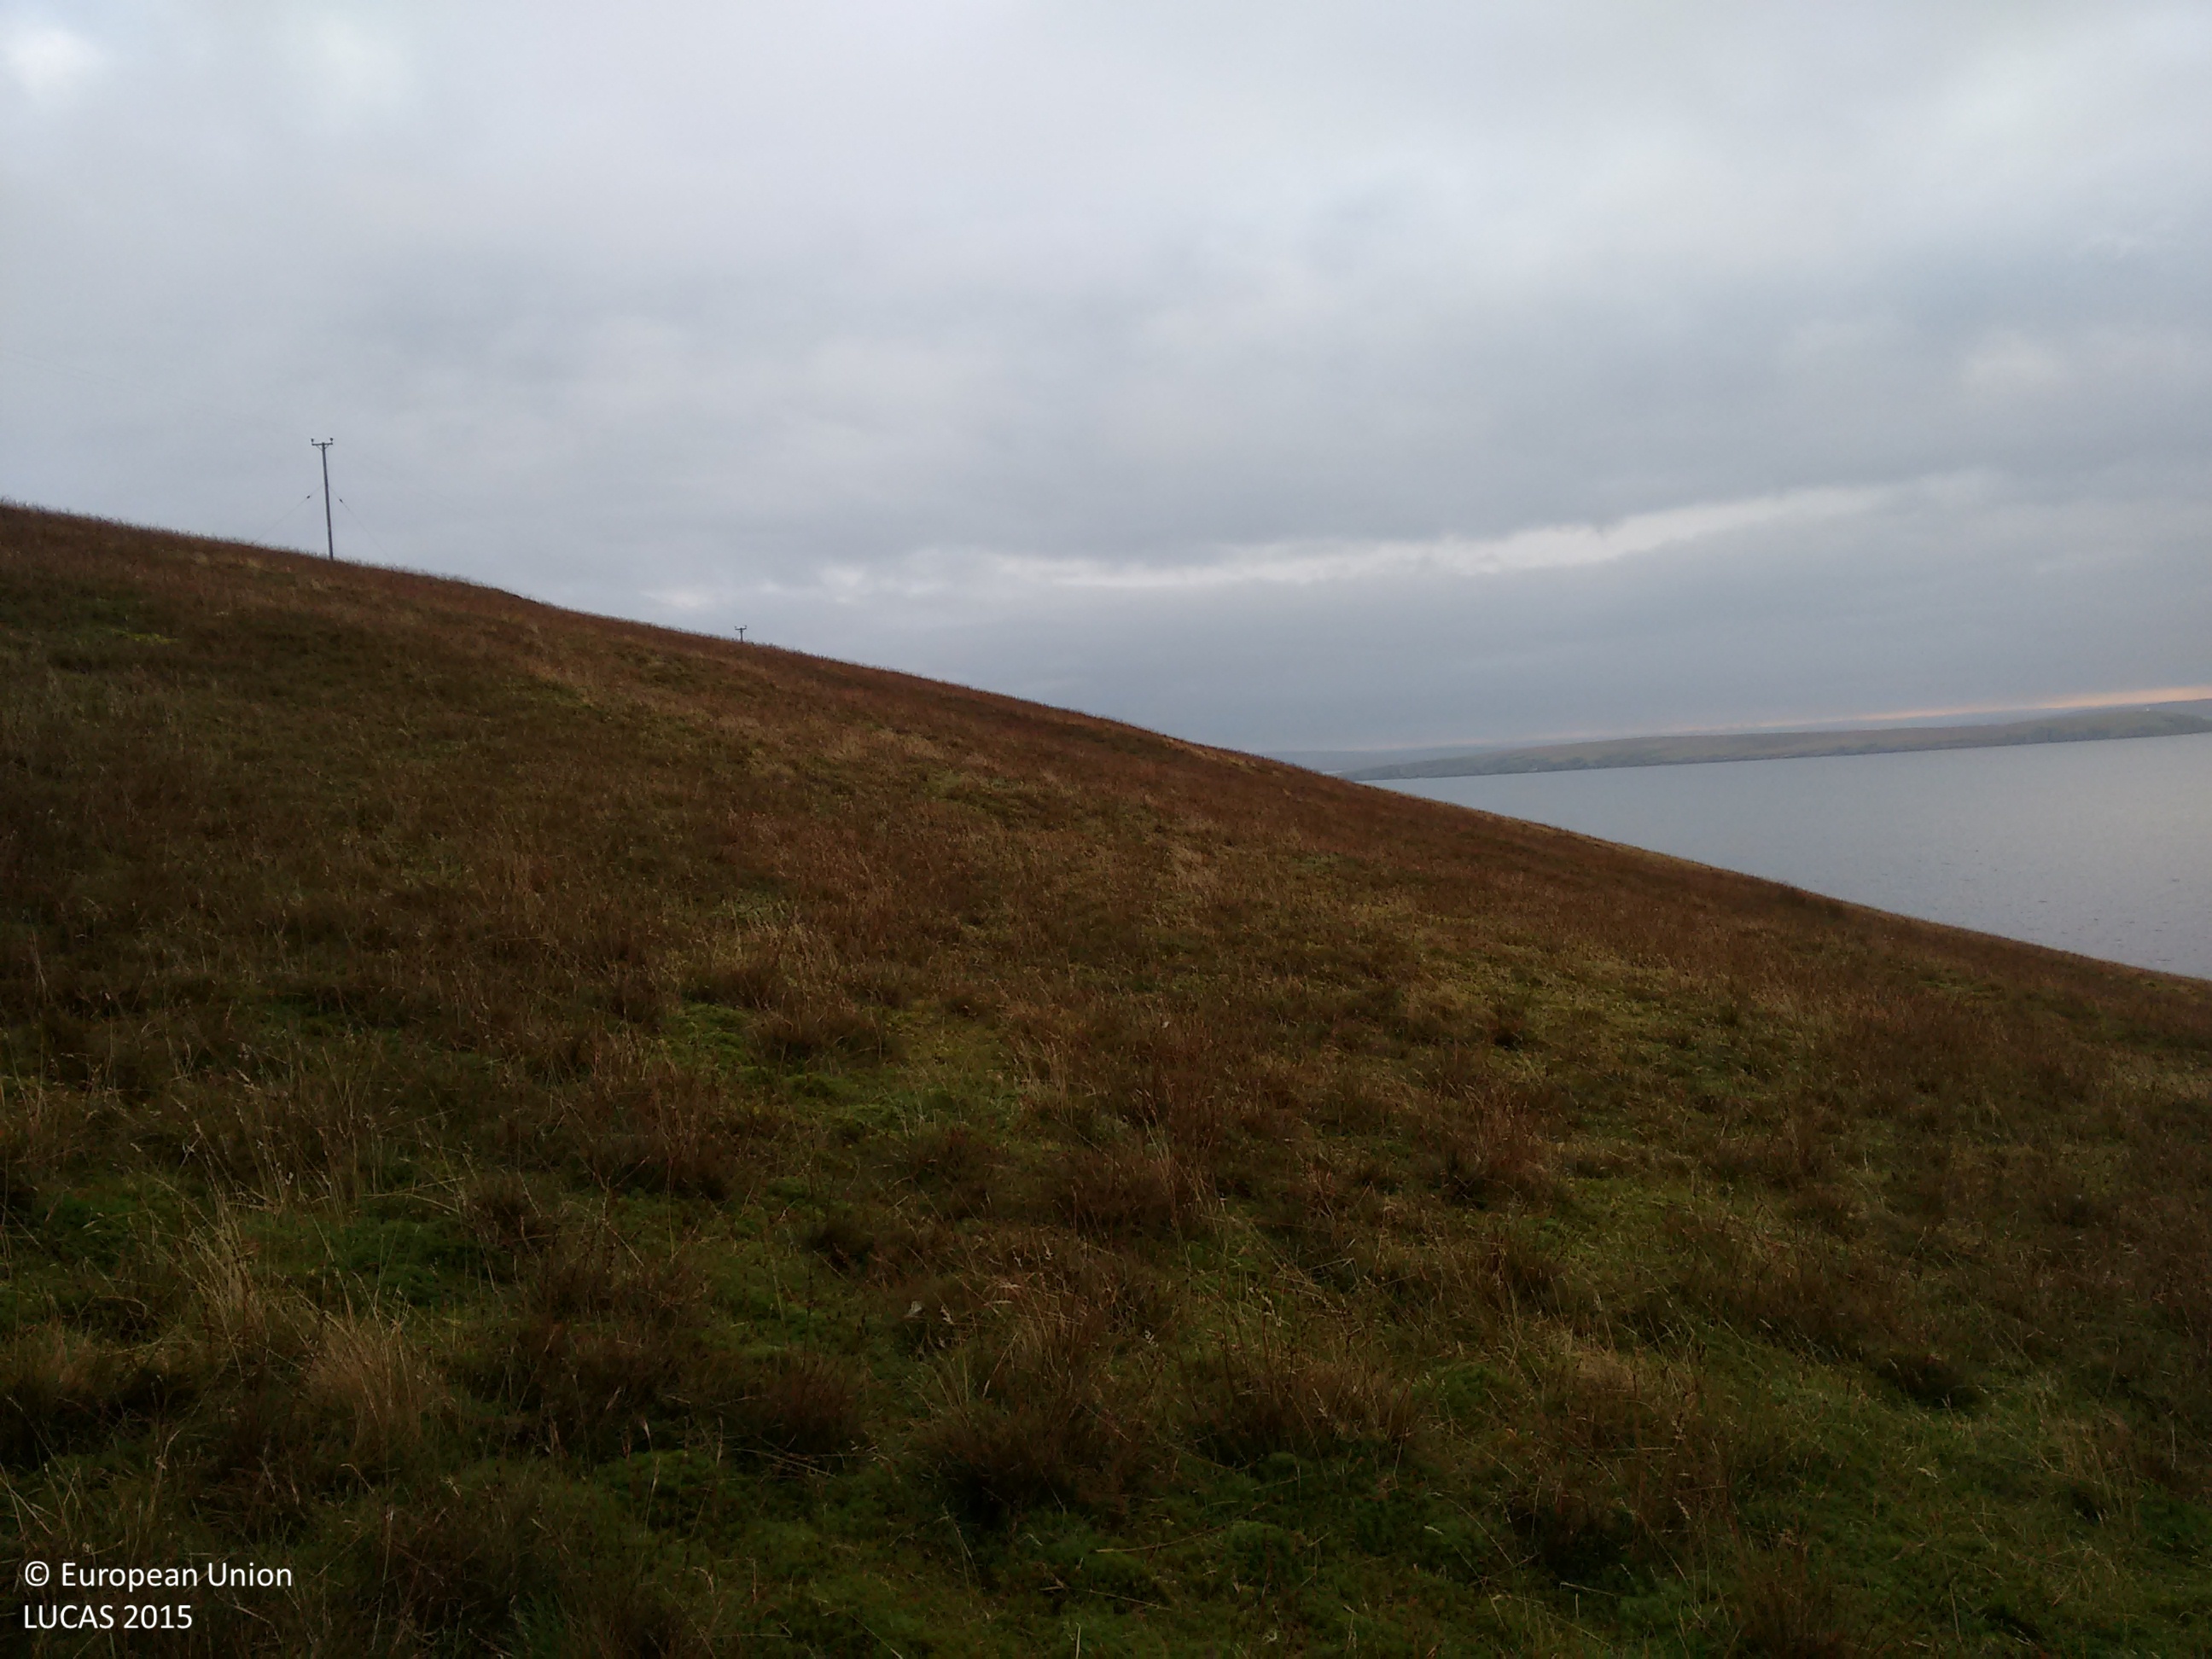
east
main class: Grassland
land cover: Grassland without tree/shrub cover
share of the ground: > 75 %
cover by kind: herbaceous plants 70 %, lichens and mosses 30 %
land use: Agriculture (excluding fallow land and kitchen gardens)
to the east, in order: Grassland without tree/shrub cover
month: November
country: GB
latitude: 60.5239
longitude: -1.3321
